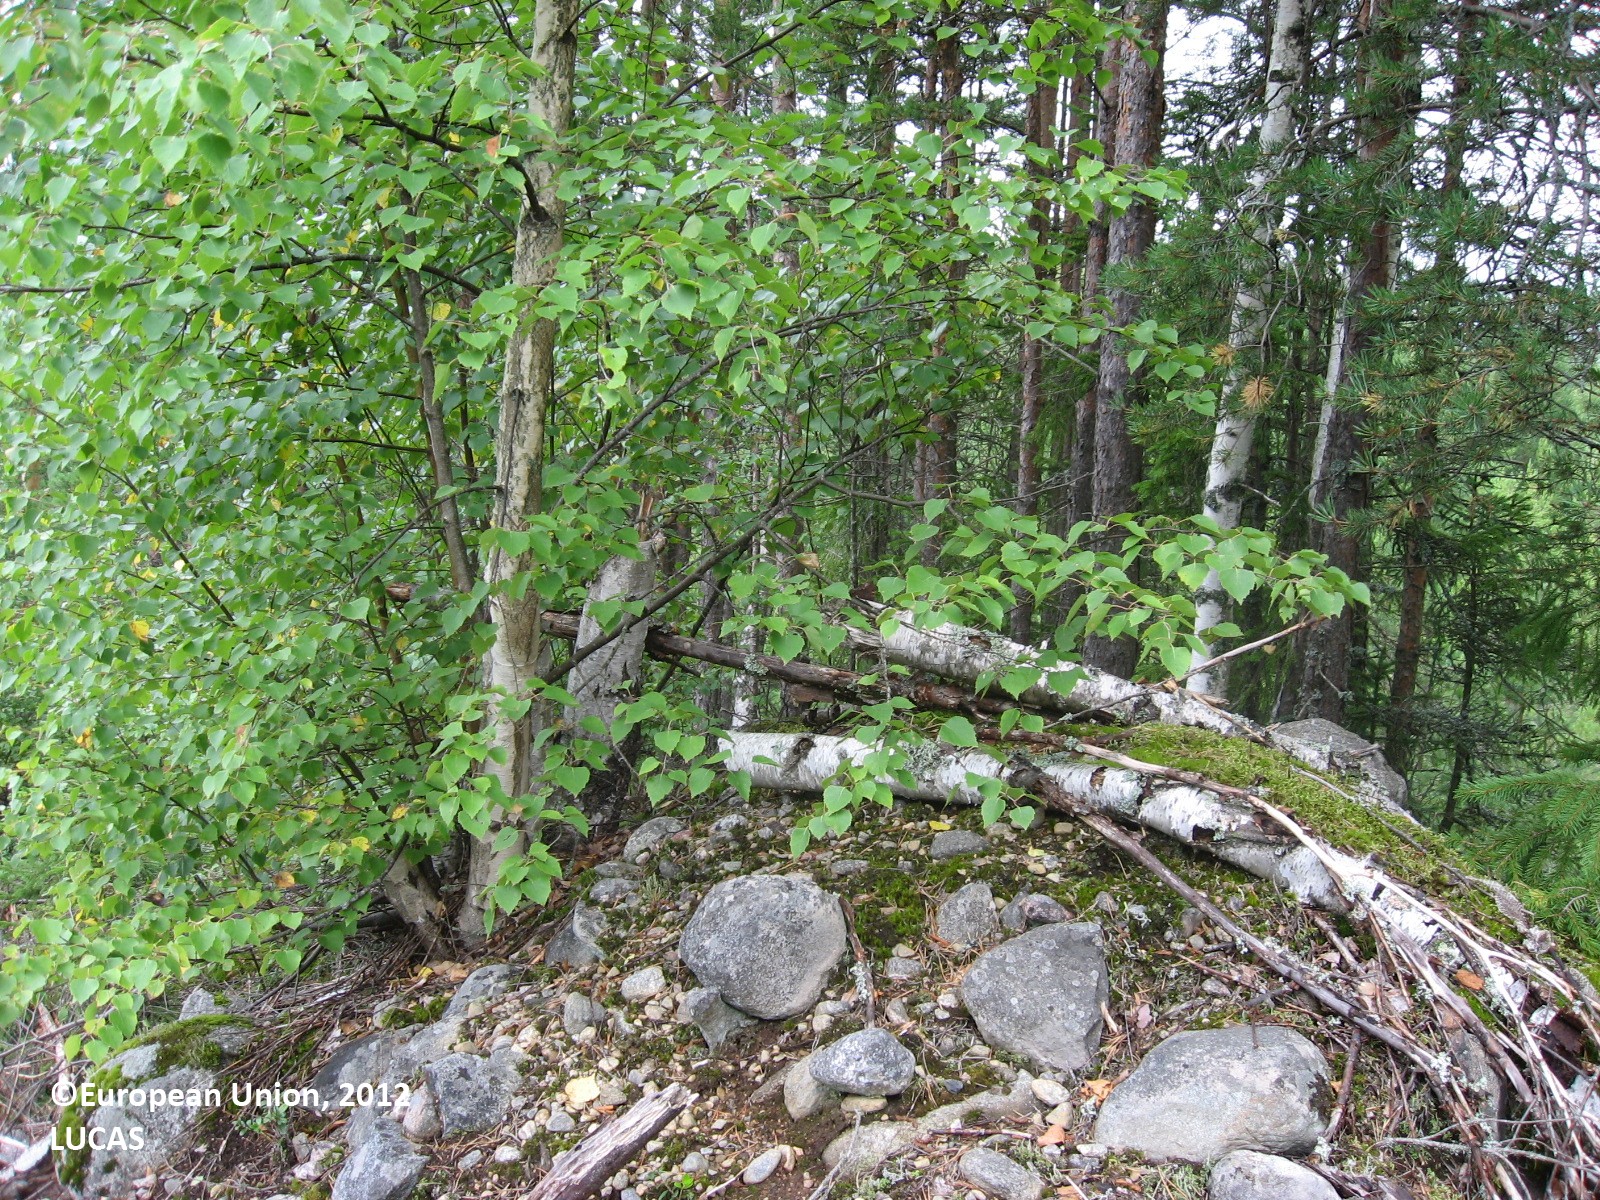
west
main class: Woodland
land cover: Spruce dominated mixed woodland
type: boreal forest
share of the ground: 50 - 75 %
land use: Forestry
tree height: < 5 m
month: August
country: FI
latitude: 60.5706
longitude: 25.4723
